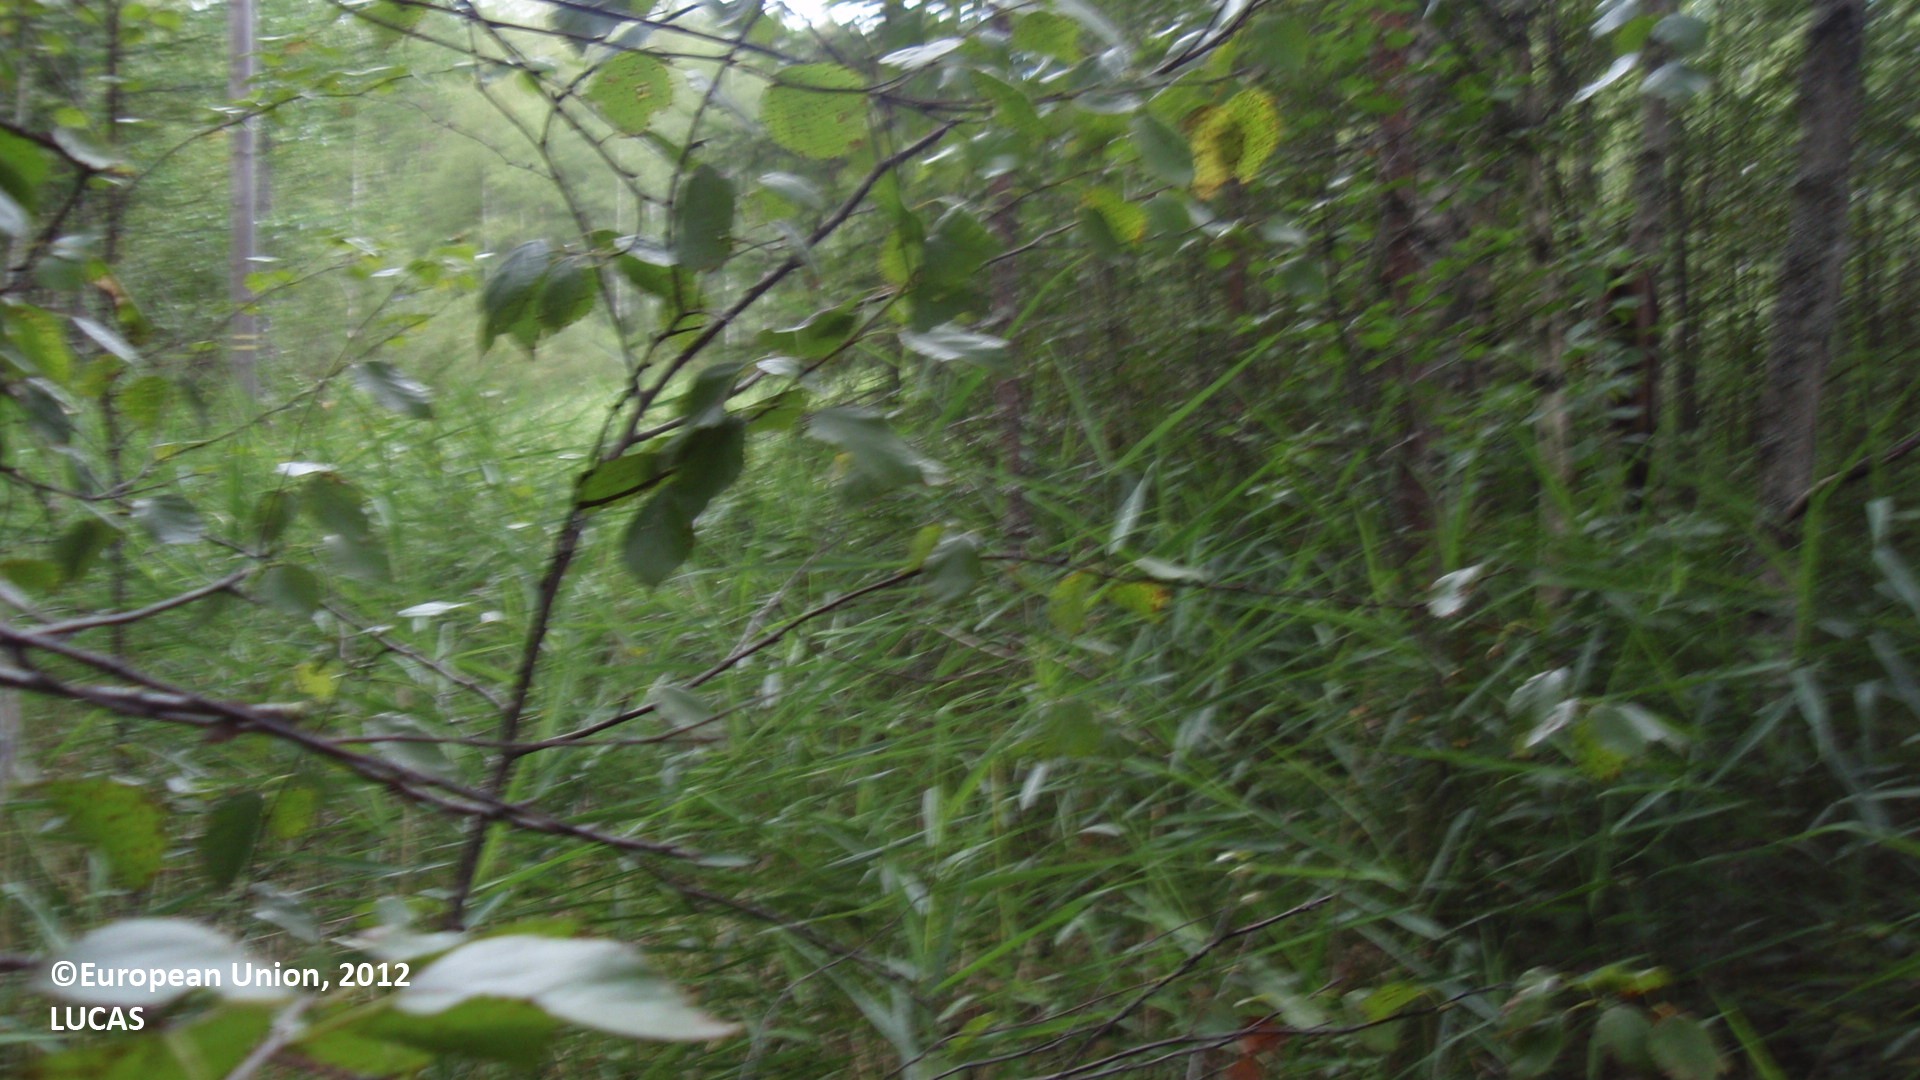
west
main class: Woodland
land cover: Broadleaved woodland
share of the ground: > 75 %
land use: Forestry
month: August
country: FI
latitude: 61.1275
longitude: 27.8098
